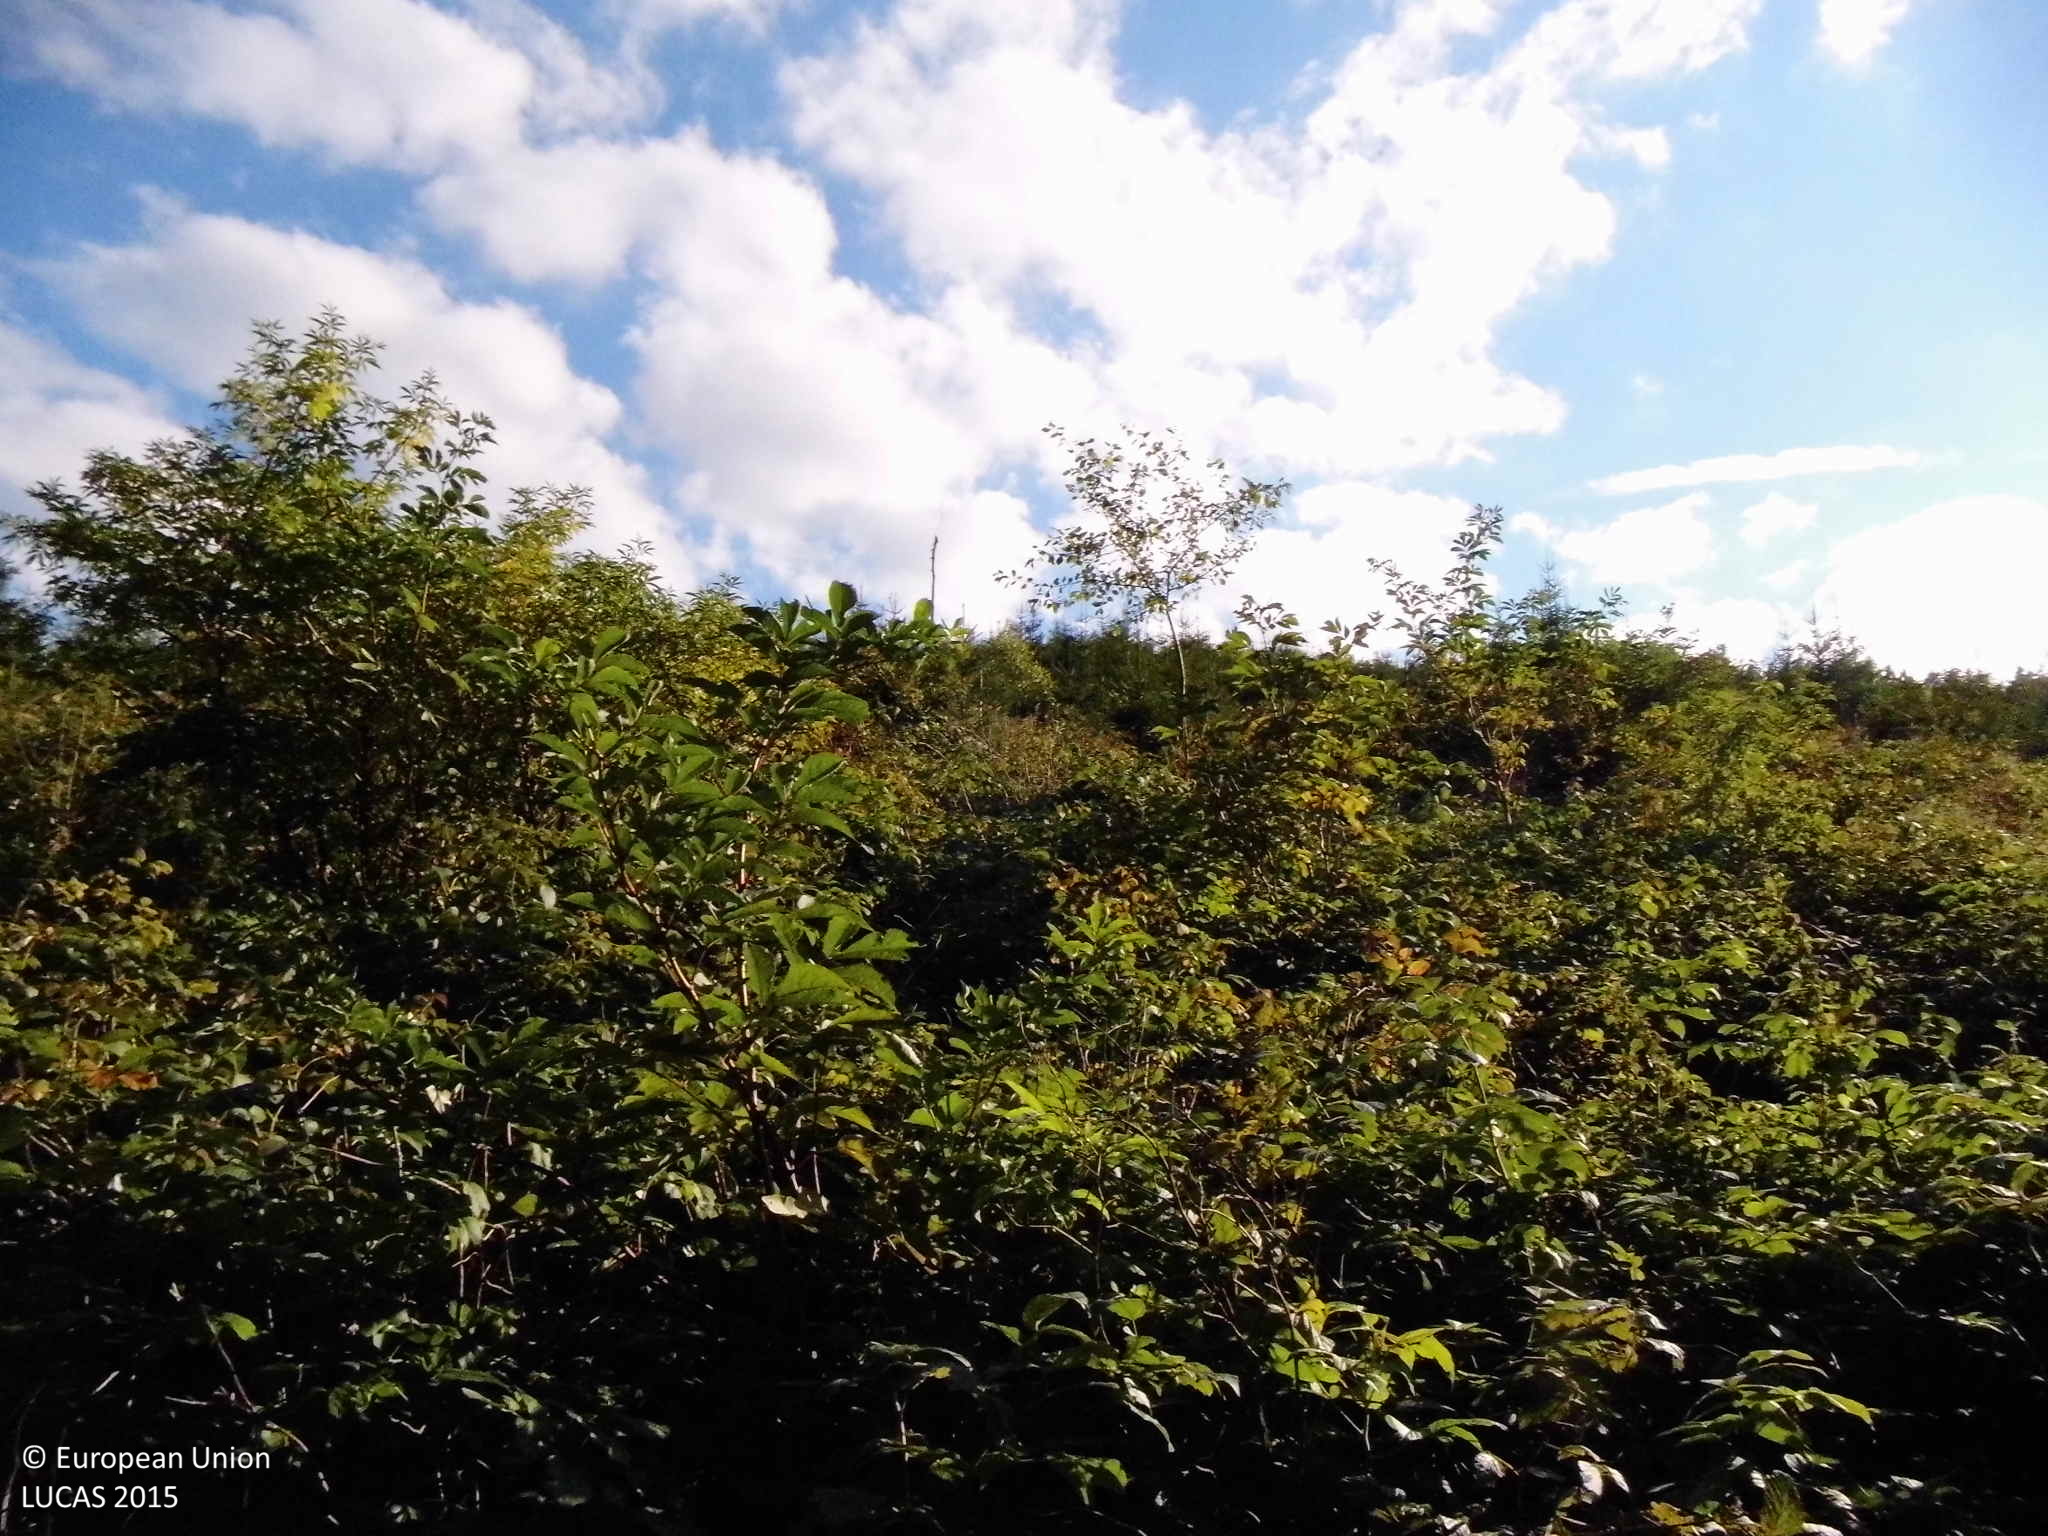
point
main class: Woodland
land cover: Spruce dominated mixed woodland
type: hemiboreal forest and nemoral coniferous forest and mixed broadleaved-coniferous forest
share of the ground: 25 - 50 %
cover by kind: shrubs 50 %, coniferous forest trees 35 %, broadleaved forest trees 15 %
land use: Forestry
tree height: < 5 m
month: September
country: DE
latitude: 51.3083
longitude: 8.5802
